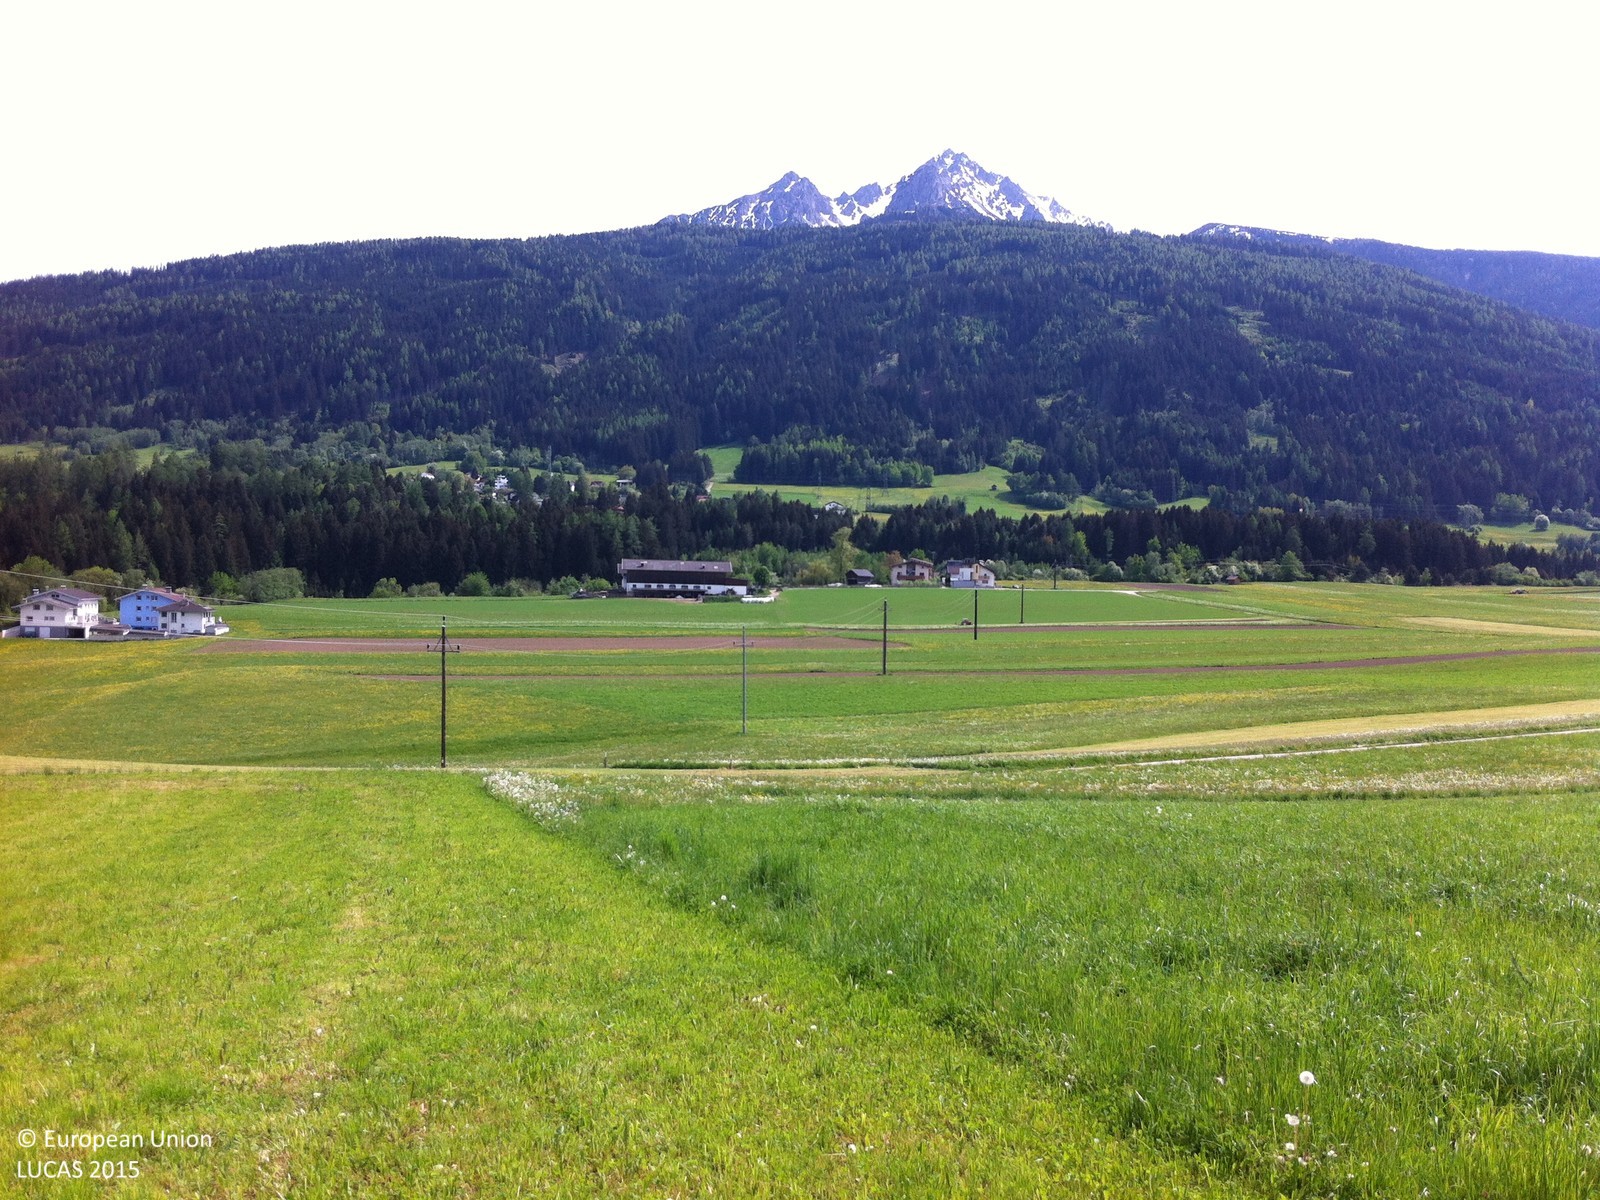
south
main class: Cropland
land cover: Temporary grasslands
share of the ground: > 75 %
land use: Agriculture (excluding fallow land and kitchen gardens)
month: May
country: AT
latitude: 47.2434
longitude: 11.3331
